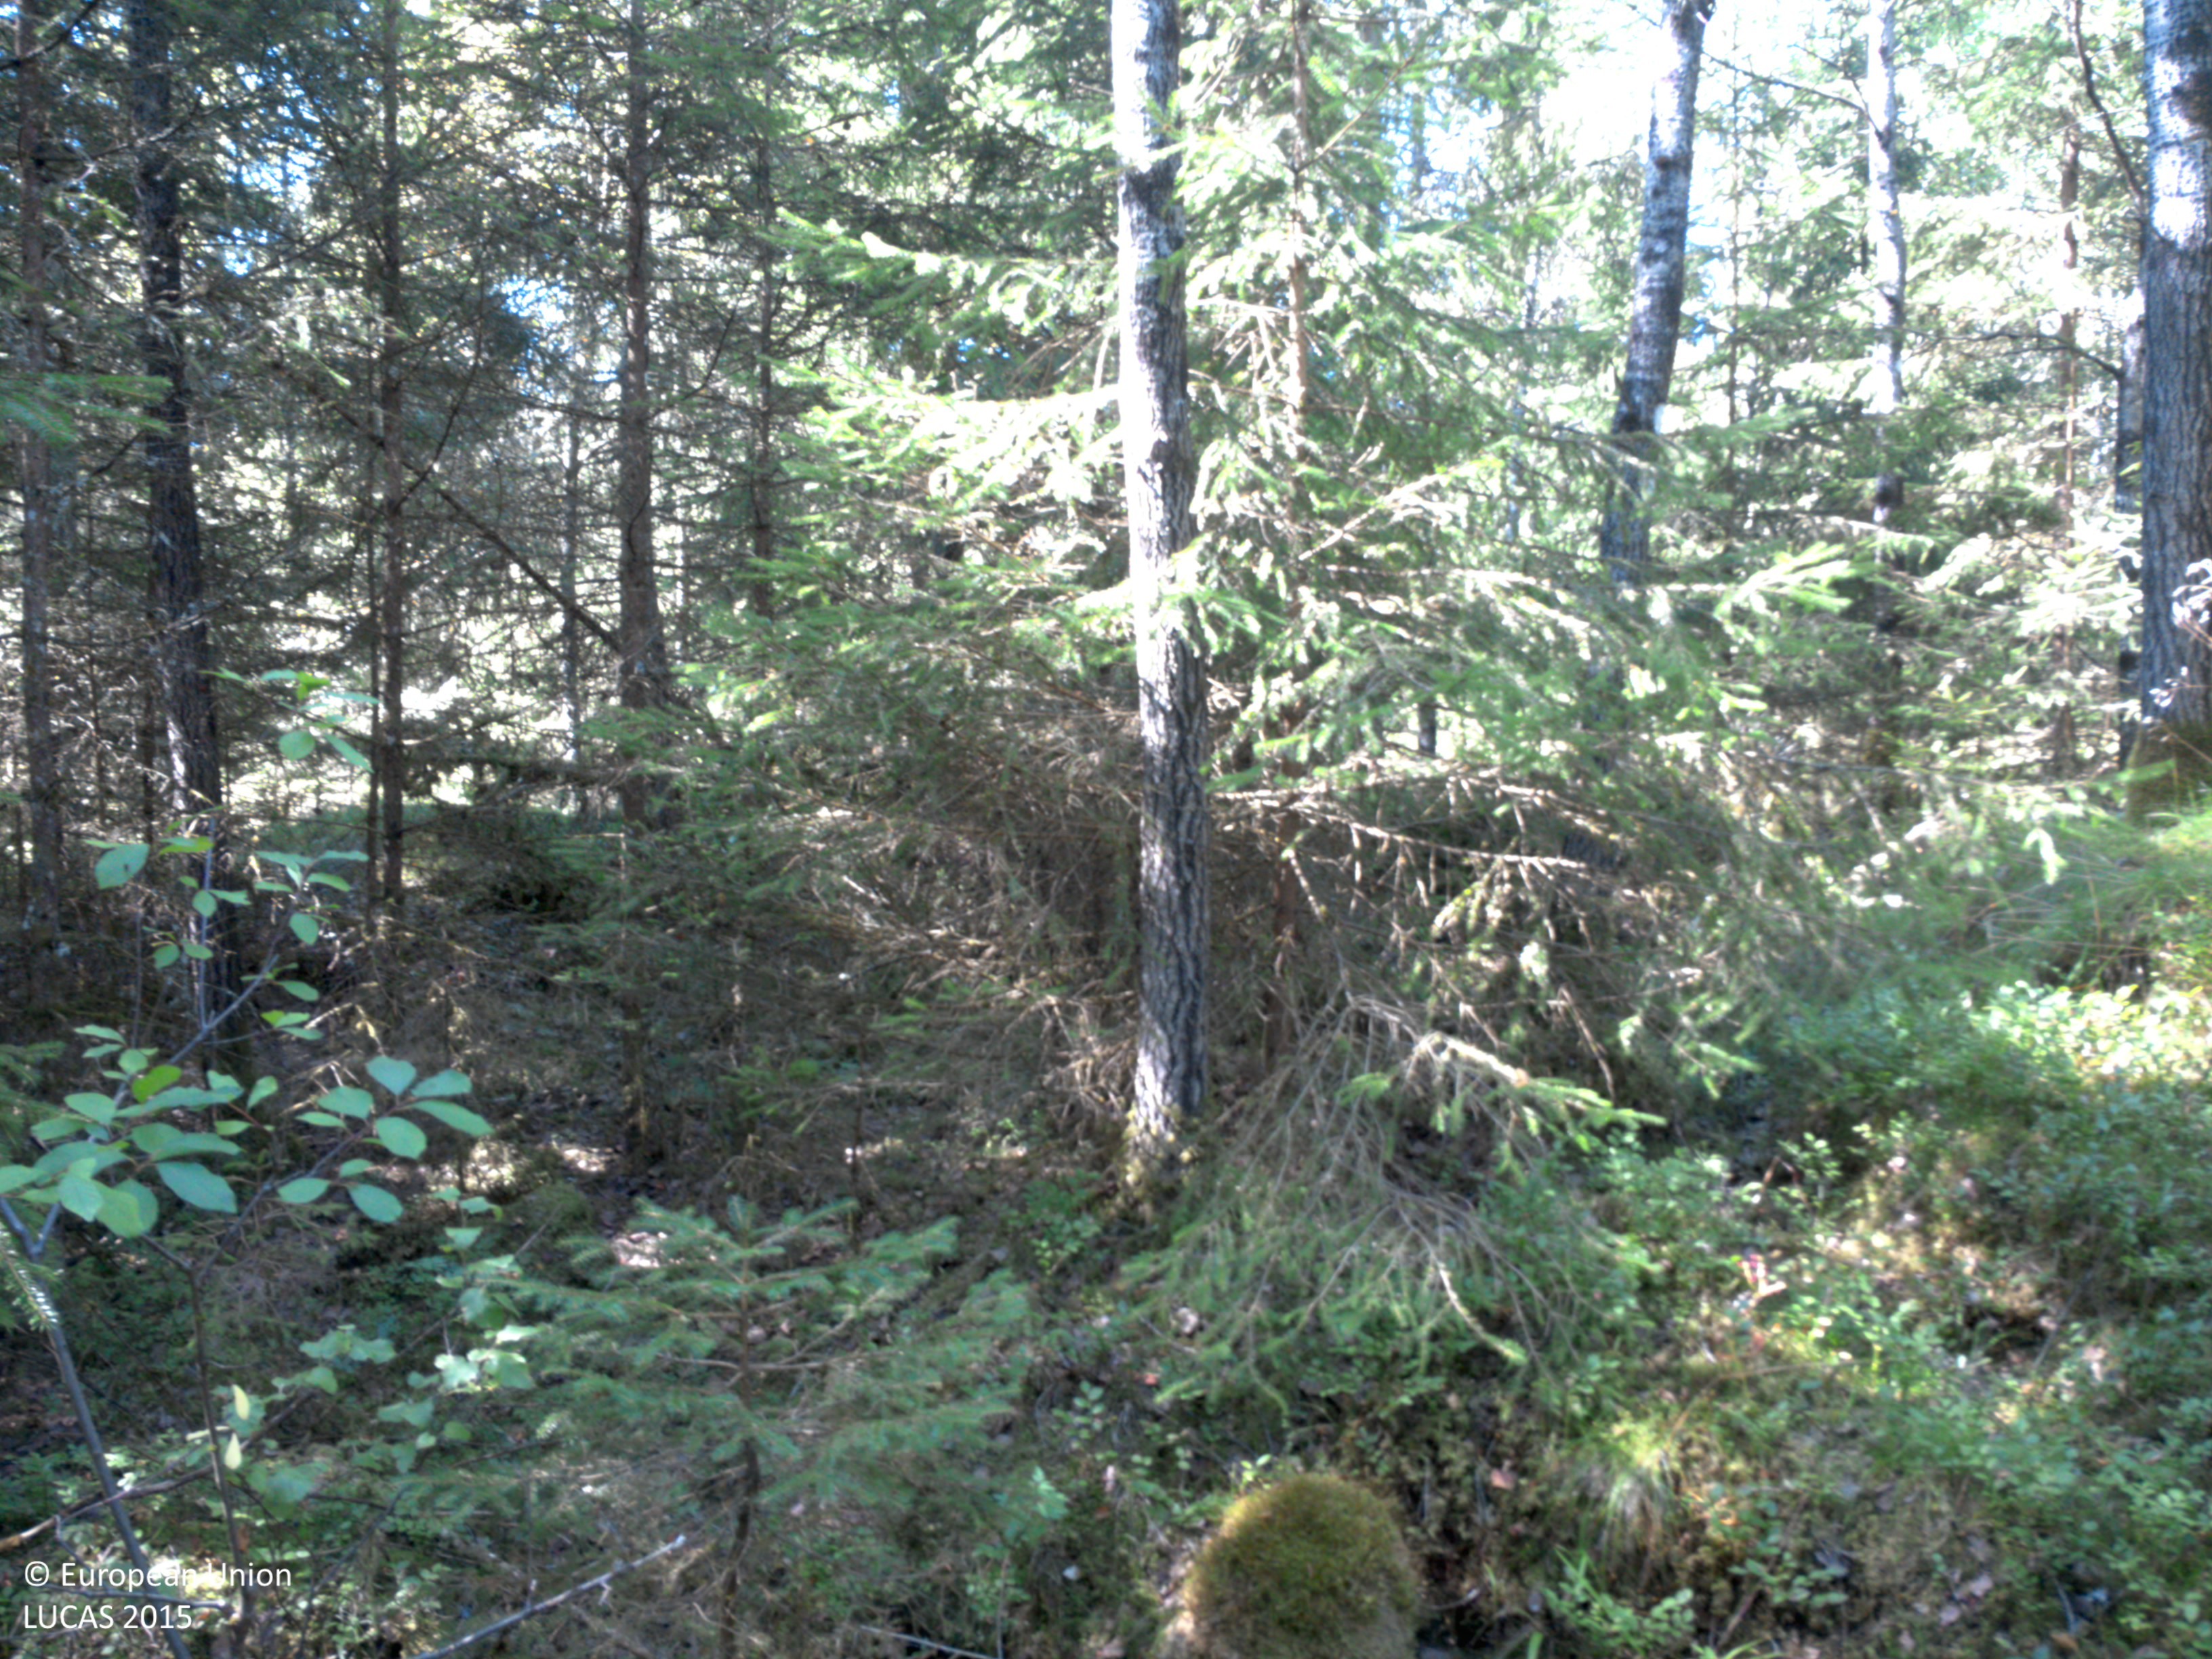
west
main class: Woodland
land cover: Spruce dominated mixed woodland
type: boreal forest
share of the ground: 50 - 75 %
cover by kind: coniferous forest trees 45 %, herbaceous plants 30 %, broadleaved forest trees 25 %
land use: Forestry
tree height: > 5 m
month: August
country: SE
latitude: 58.5474
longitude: 11.9375
